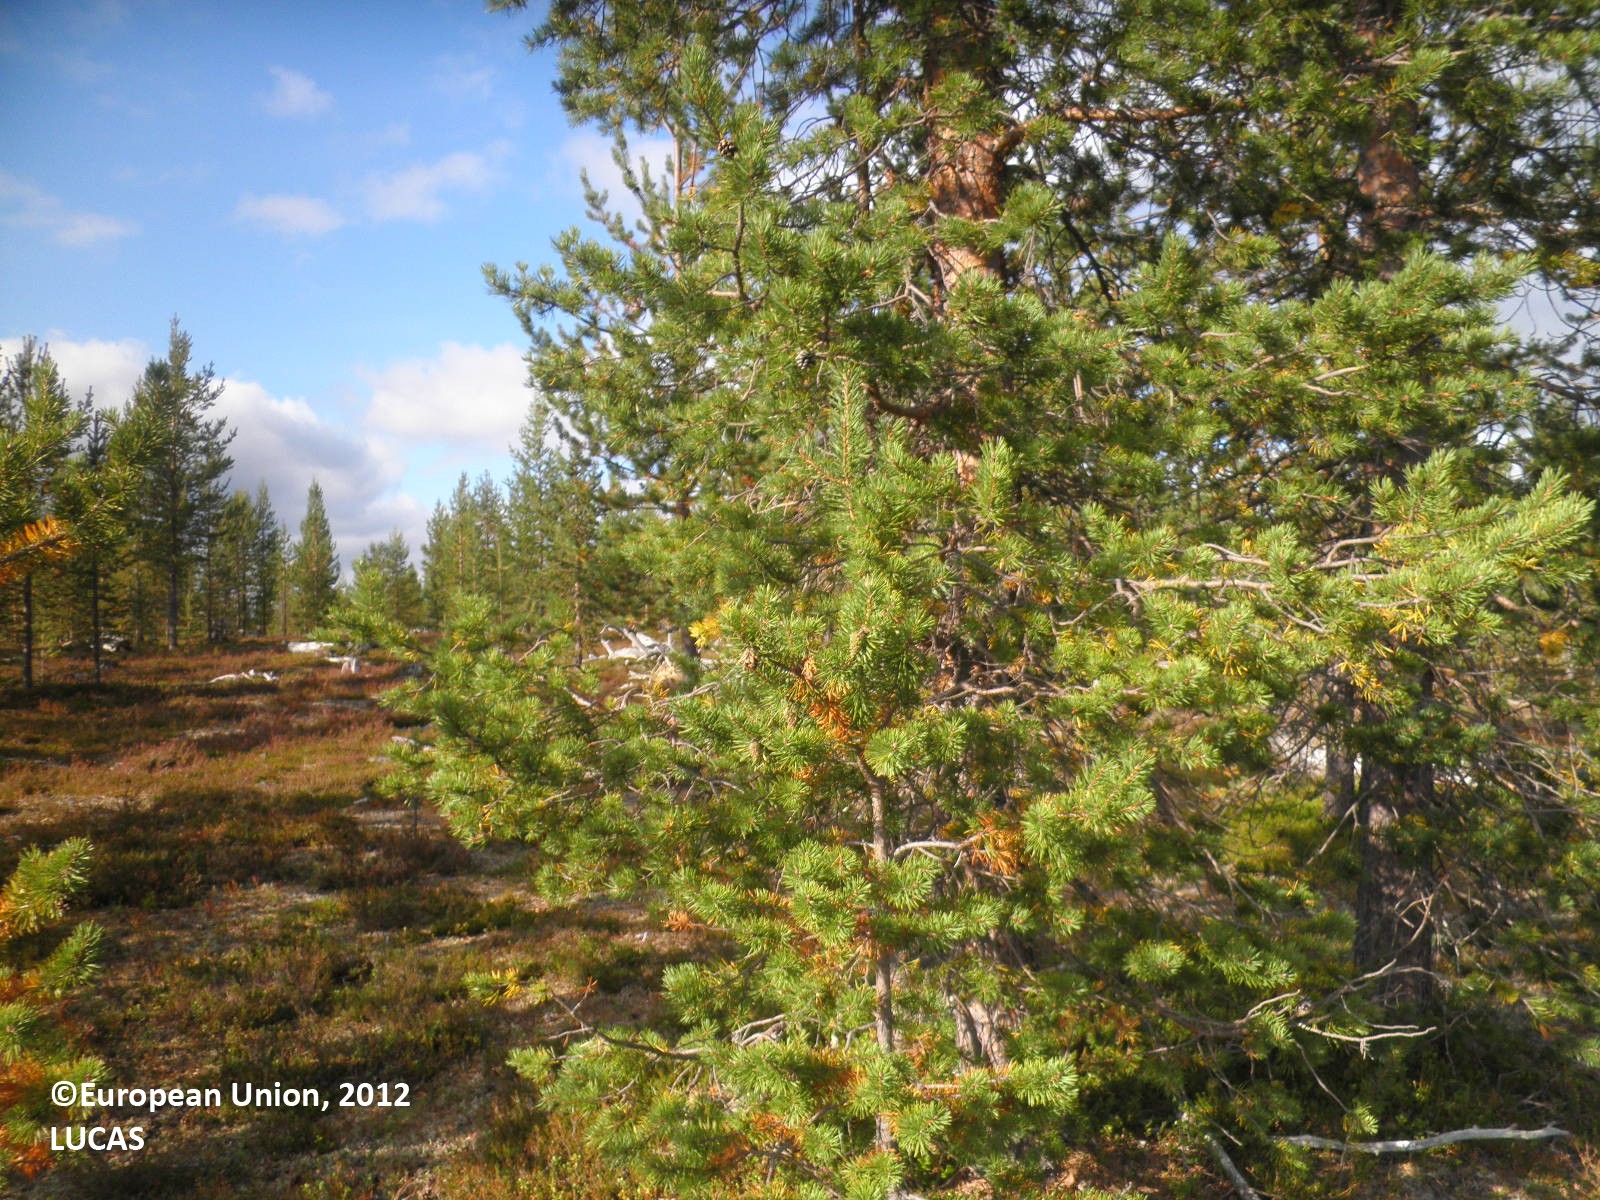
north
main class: Woodland
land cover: Pine dominated coniferous woodland
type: boreal forest
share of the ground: 10 - 25 %
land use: Forestry
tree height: > 5 m
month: August
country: FI
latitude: 67.9008
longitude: 29.0274
